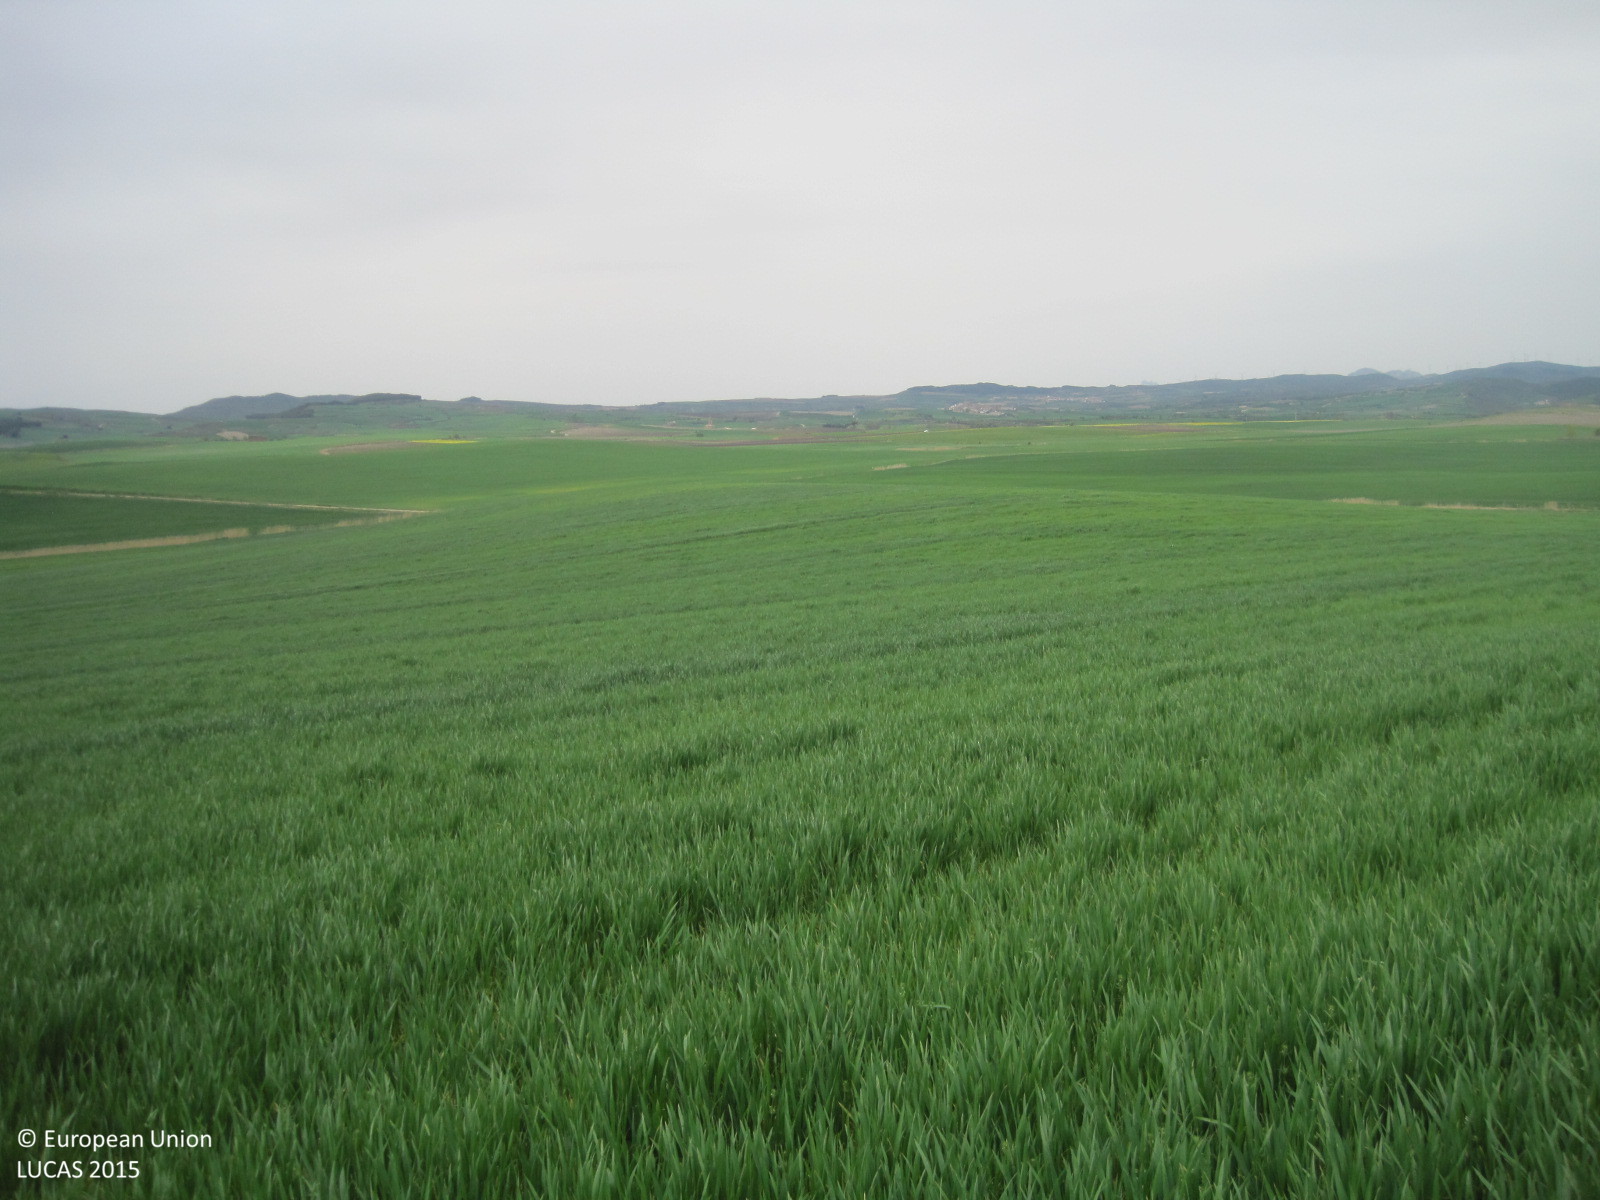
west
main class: Cropland
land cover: Barley
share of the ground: > 75 %
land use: Agriculture (excluding fallow land and kitchen gardens)
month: April
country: ES
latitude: 42.5510
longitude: -2.2091
